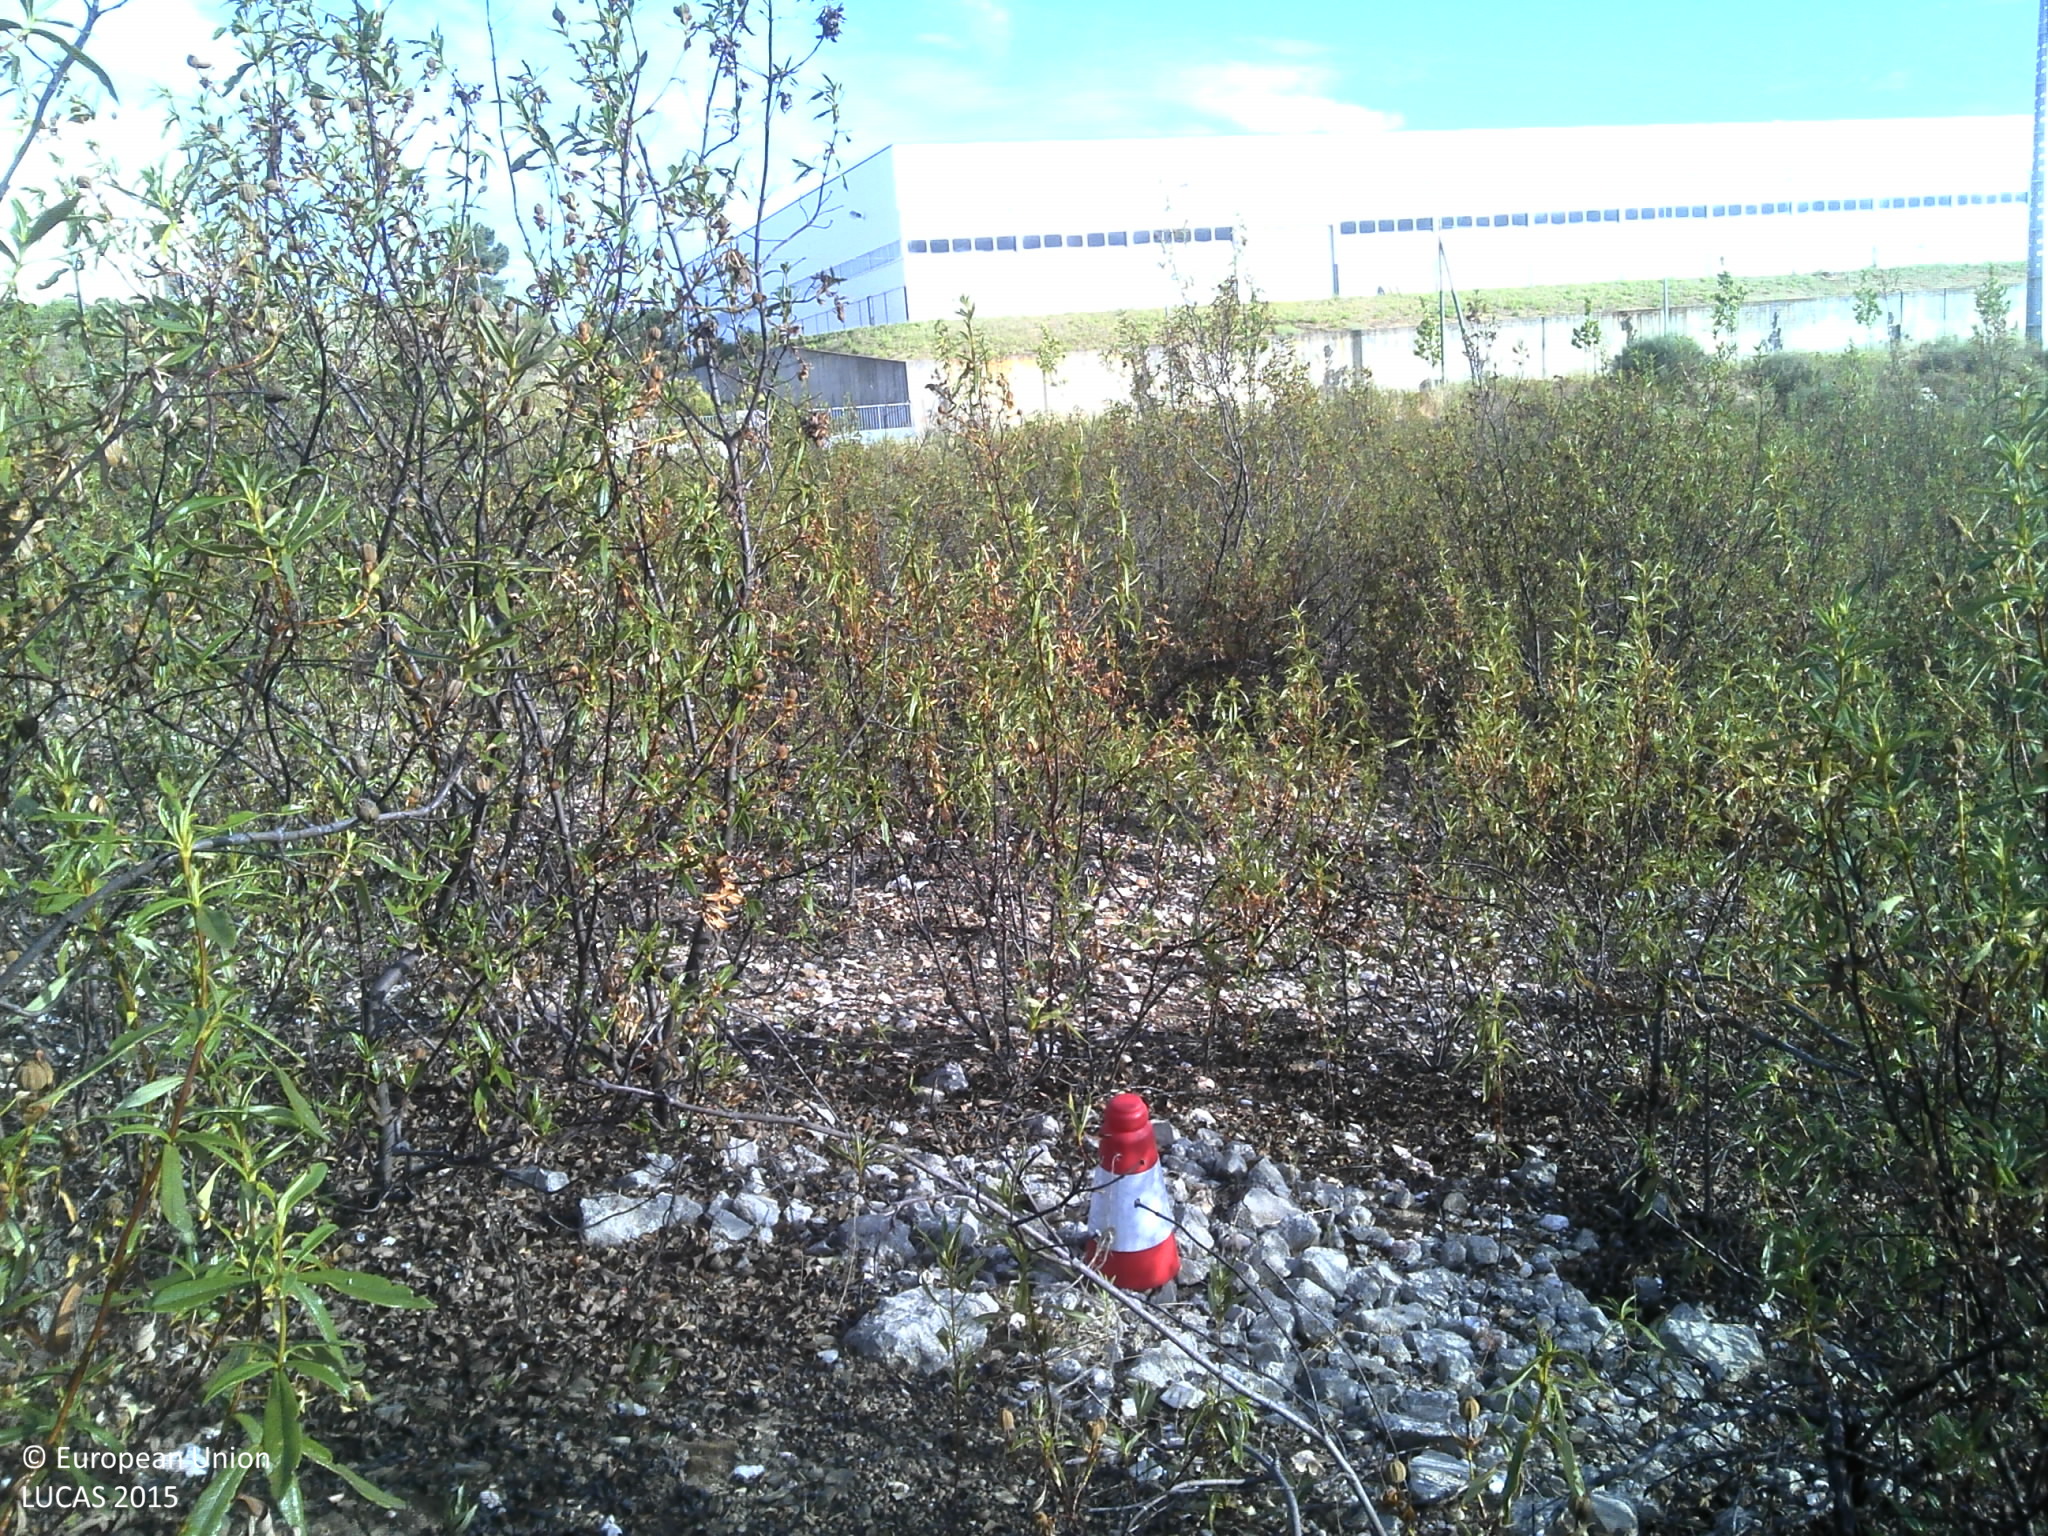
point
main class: Shrubland
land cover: Shrubland without tree cover
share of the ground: 25 - 50 %
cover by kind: shrubs 50 %, unconsolidated bare surface 50 %
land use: Construction
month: July
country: PT
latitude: 39.8000
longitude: -7.5368
